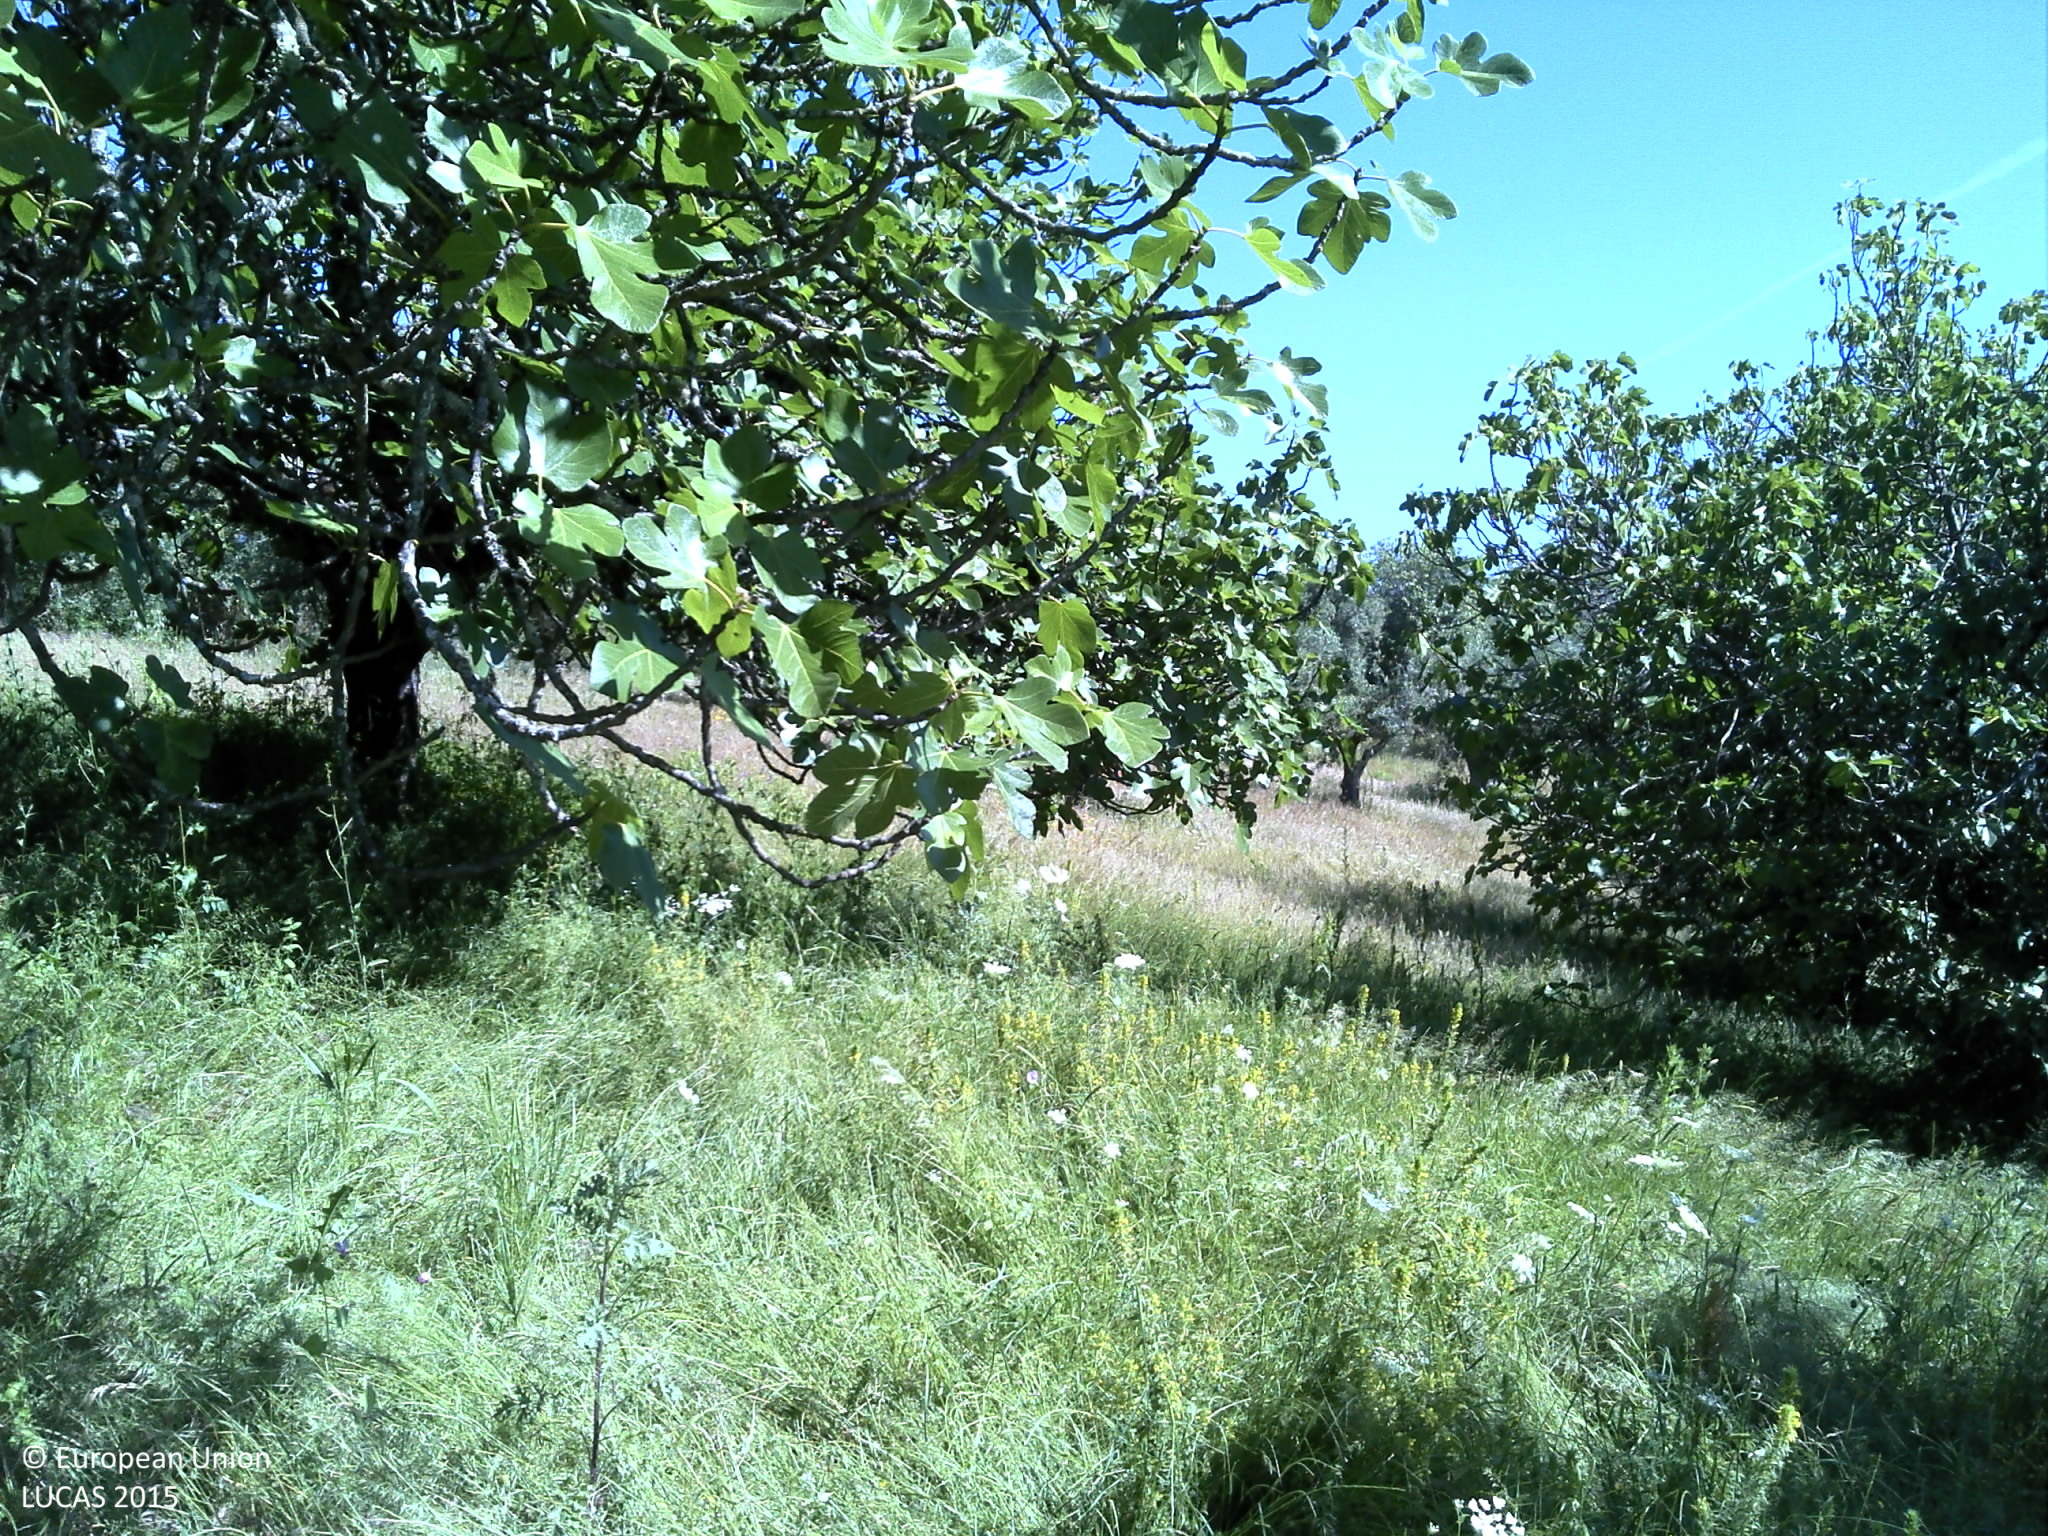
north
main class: Cropland
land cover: Other fruit trees and berries
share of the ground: 25 - 50 %
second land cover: Grassland without tree/shrub cover
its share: 25 - 50 %
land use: Agriculture (excluding fallow land and kitchen gardens)
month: May
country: PT
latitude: 39.5682
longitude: -8.4765
